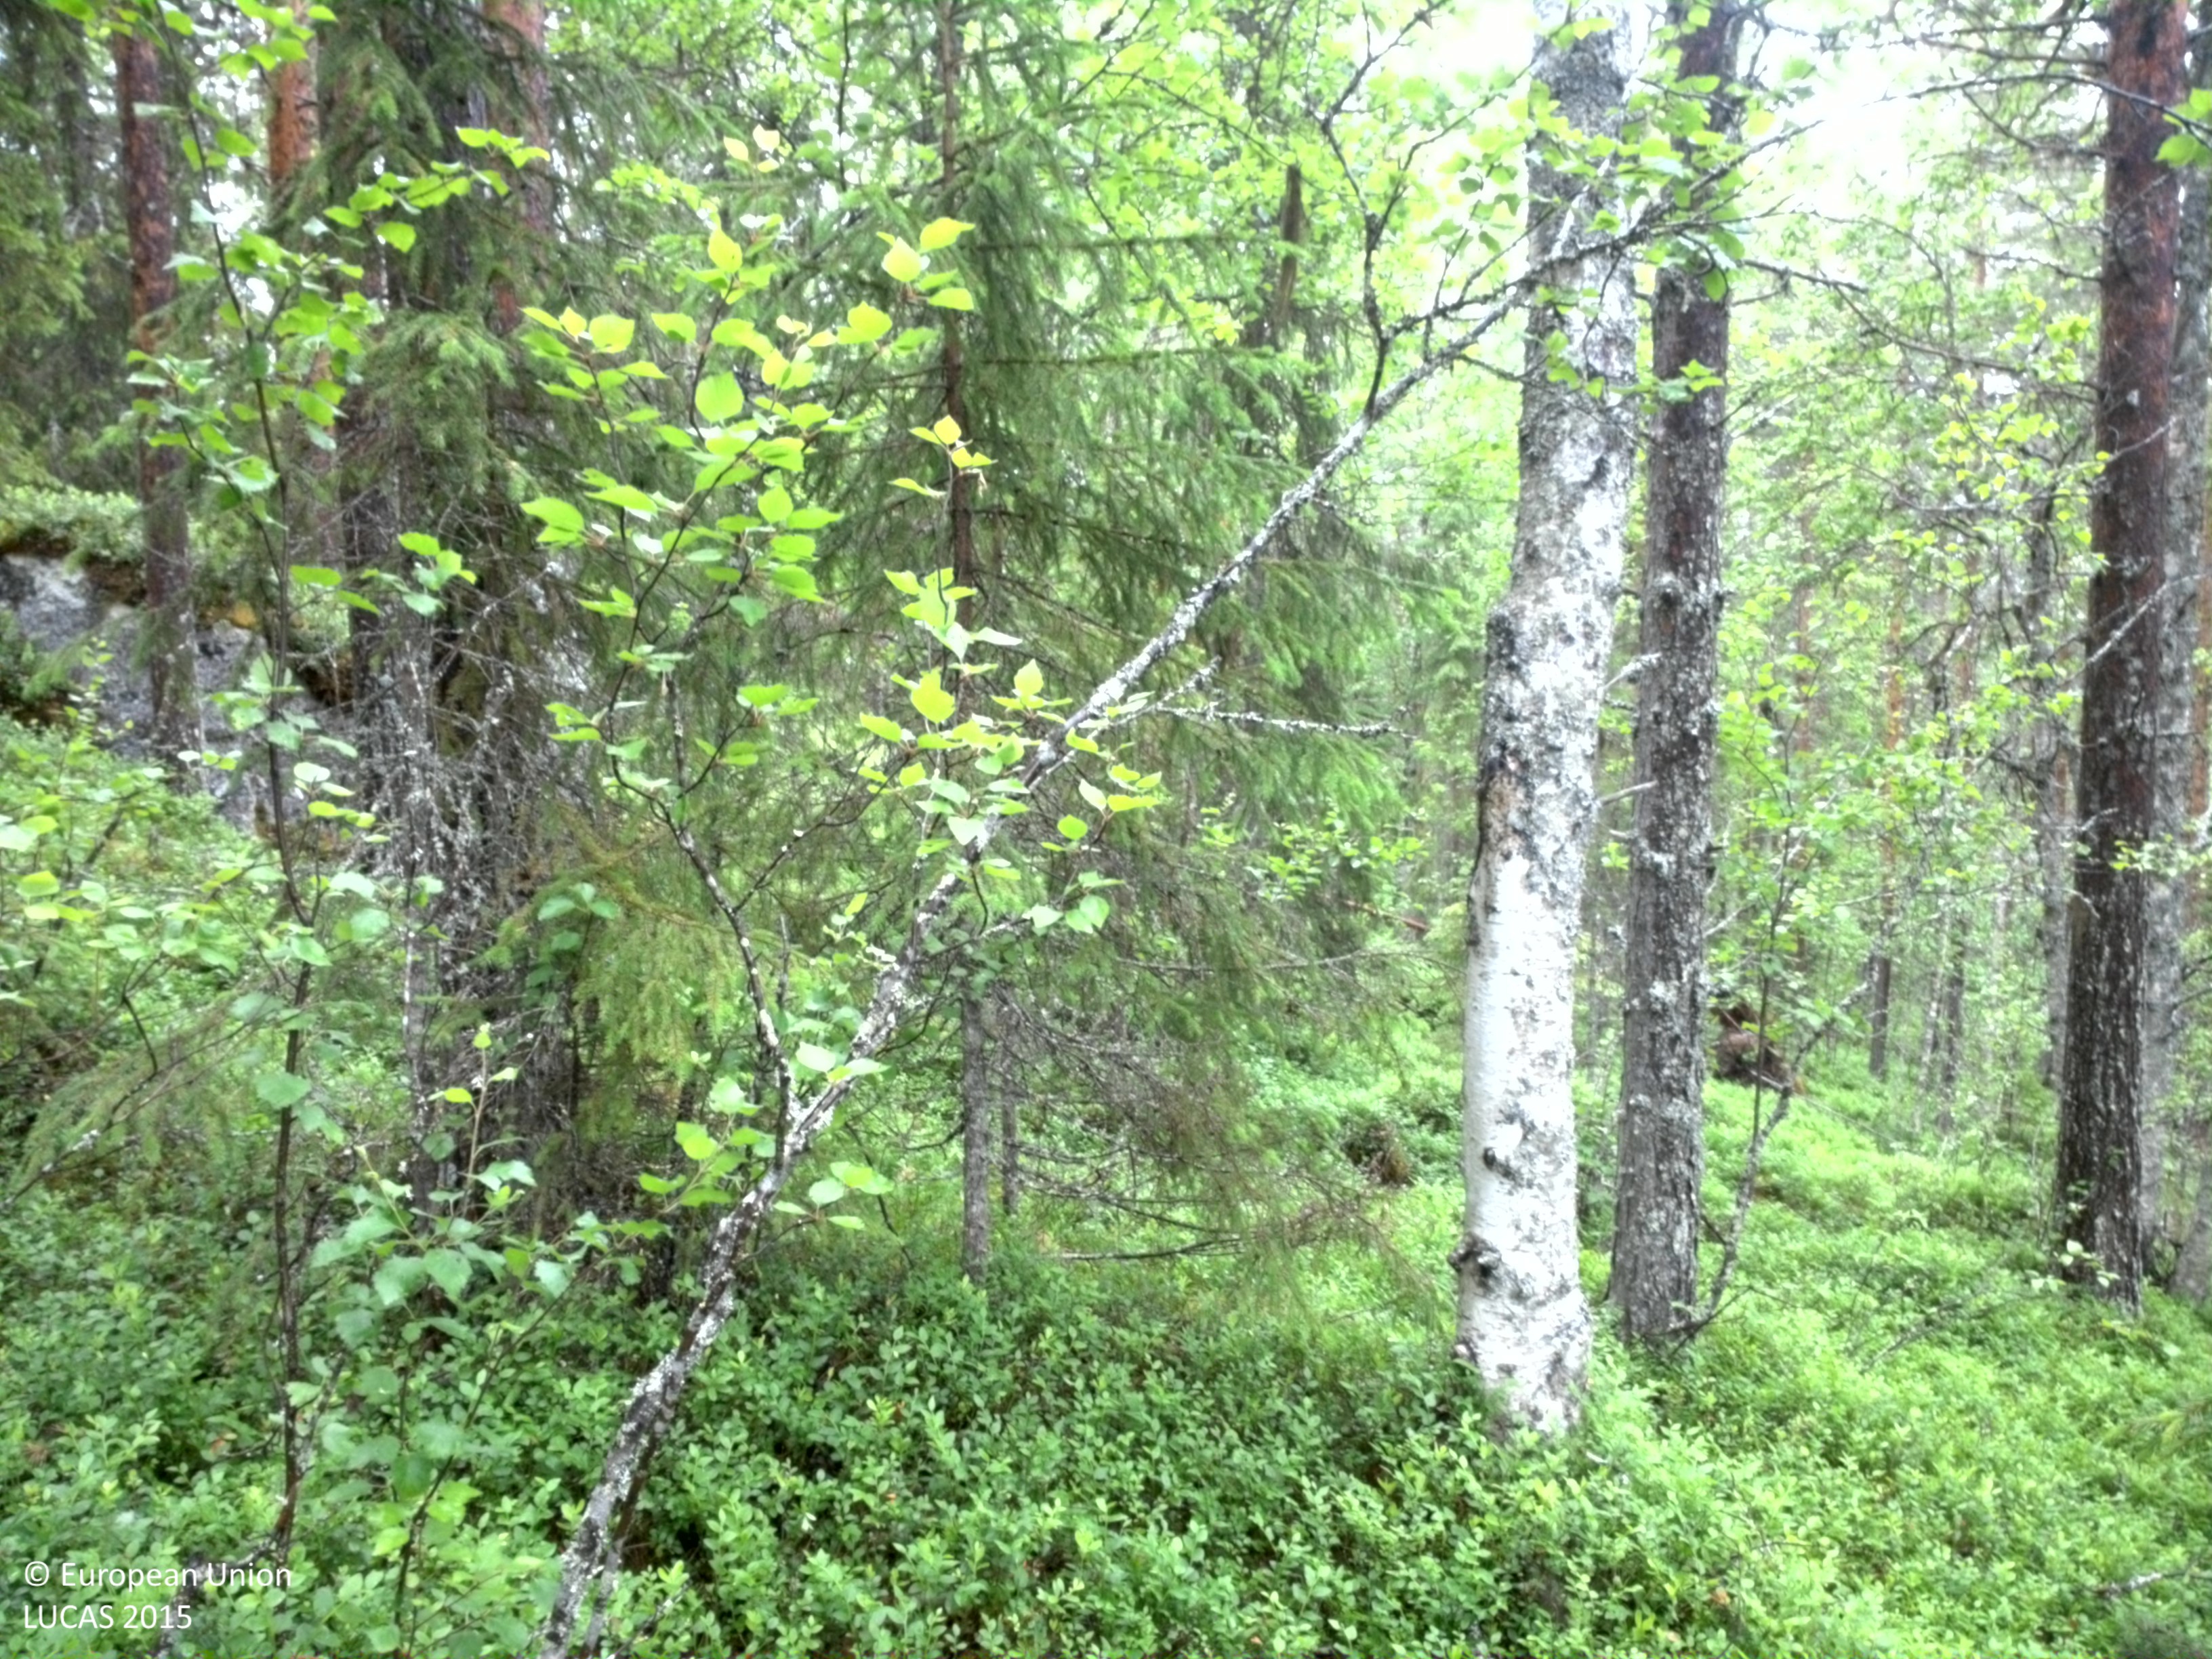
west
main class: Woodland
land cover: Pine dominated coniferous woodland
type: hemiboreal forest and nemoral coniferous forest and mixed broadleaved-coniferous forest
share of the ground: 50 - 75 %
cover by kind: coniferous forest trees 65 %, shrubs 20 %, broadleaved forest trees 10 %, lichens and mosses 5 %
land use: Forestry
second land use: Amenities, museums, leisure
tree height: > 5 m
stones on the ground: 10 - 25 %
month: July
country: SE
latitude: 64.6207
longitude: 18.2267
